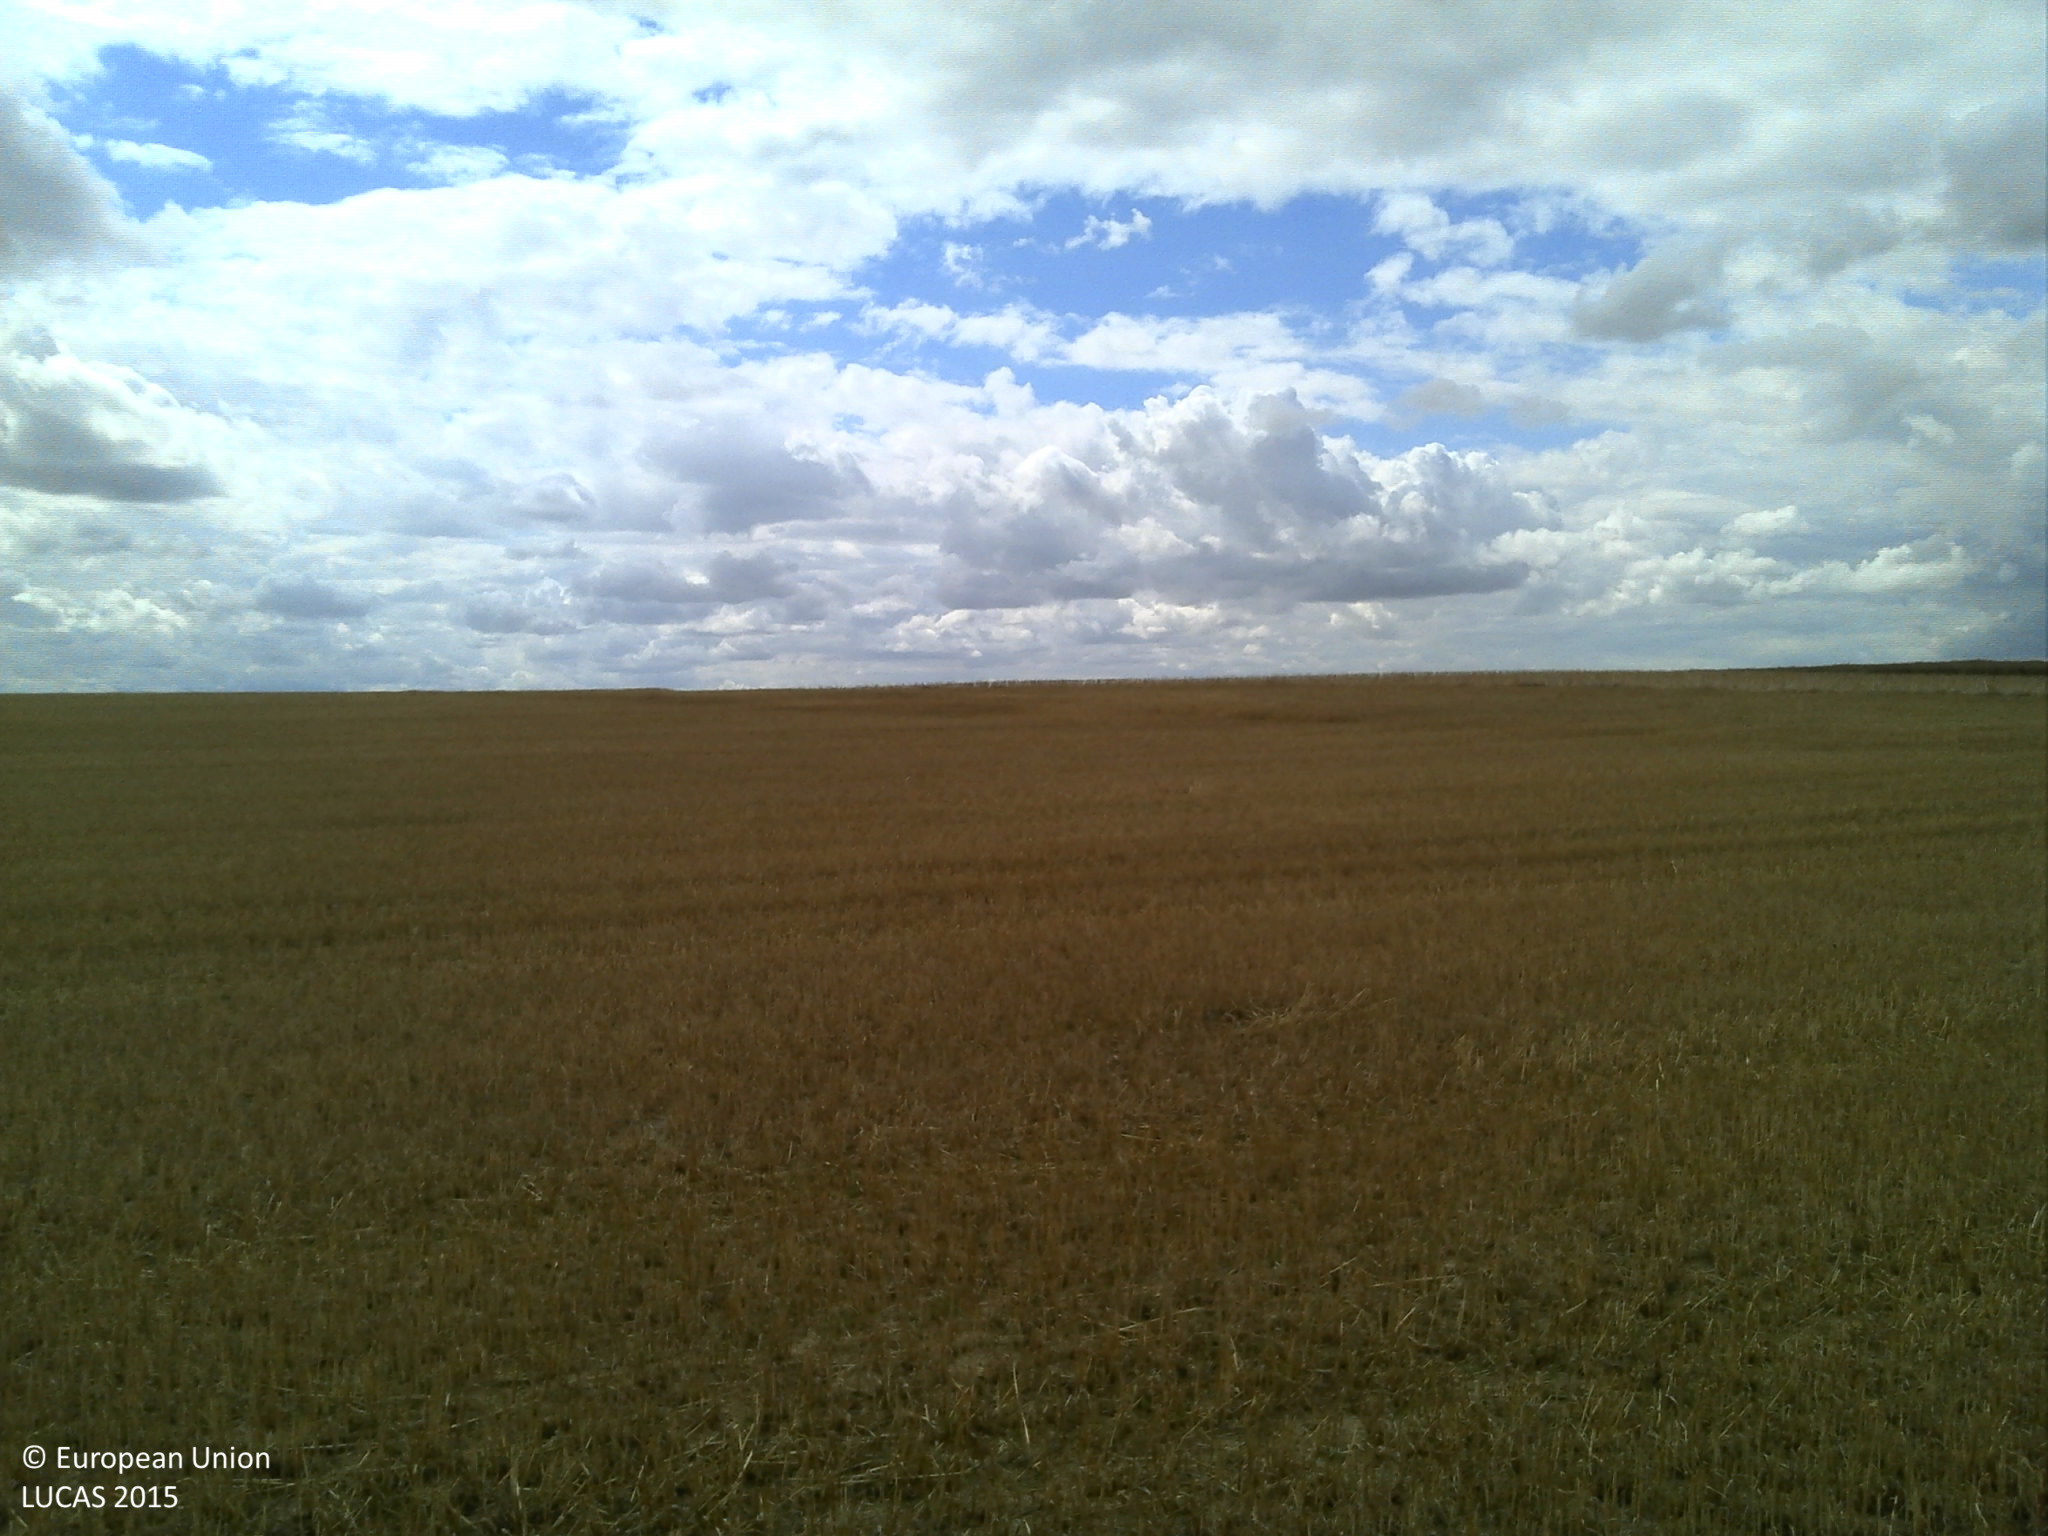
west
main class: Cropland
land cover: Barley
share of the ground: 50 - 75 %
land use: Agriculture (excluding fallow land and kitchen gardens)
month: July
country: FR
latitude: 49.3501
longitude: 4.5314
